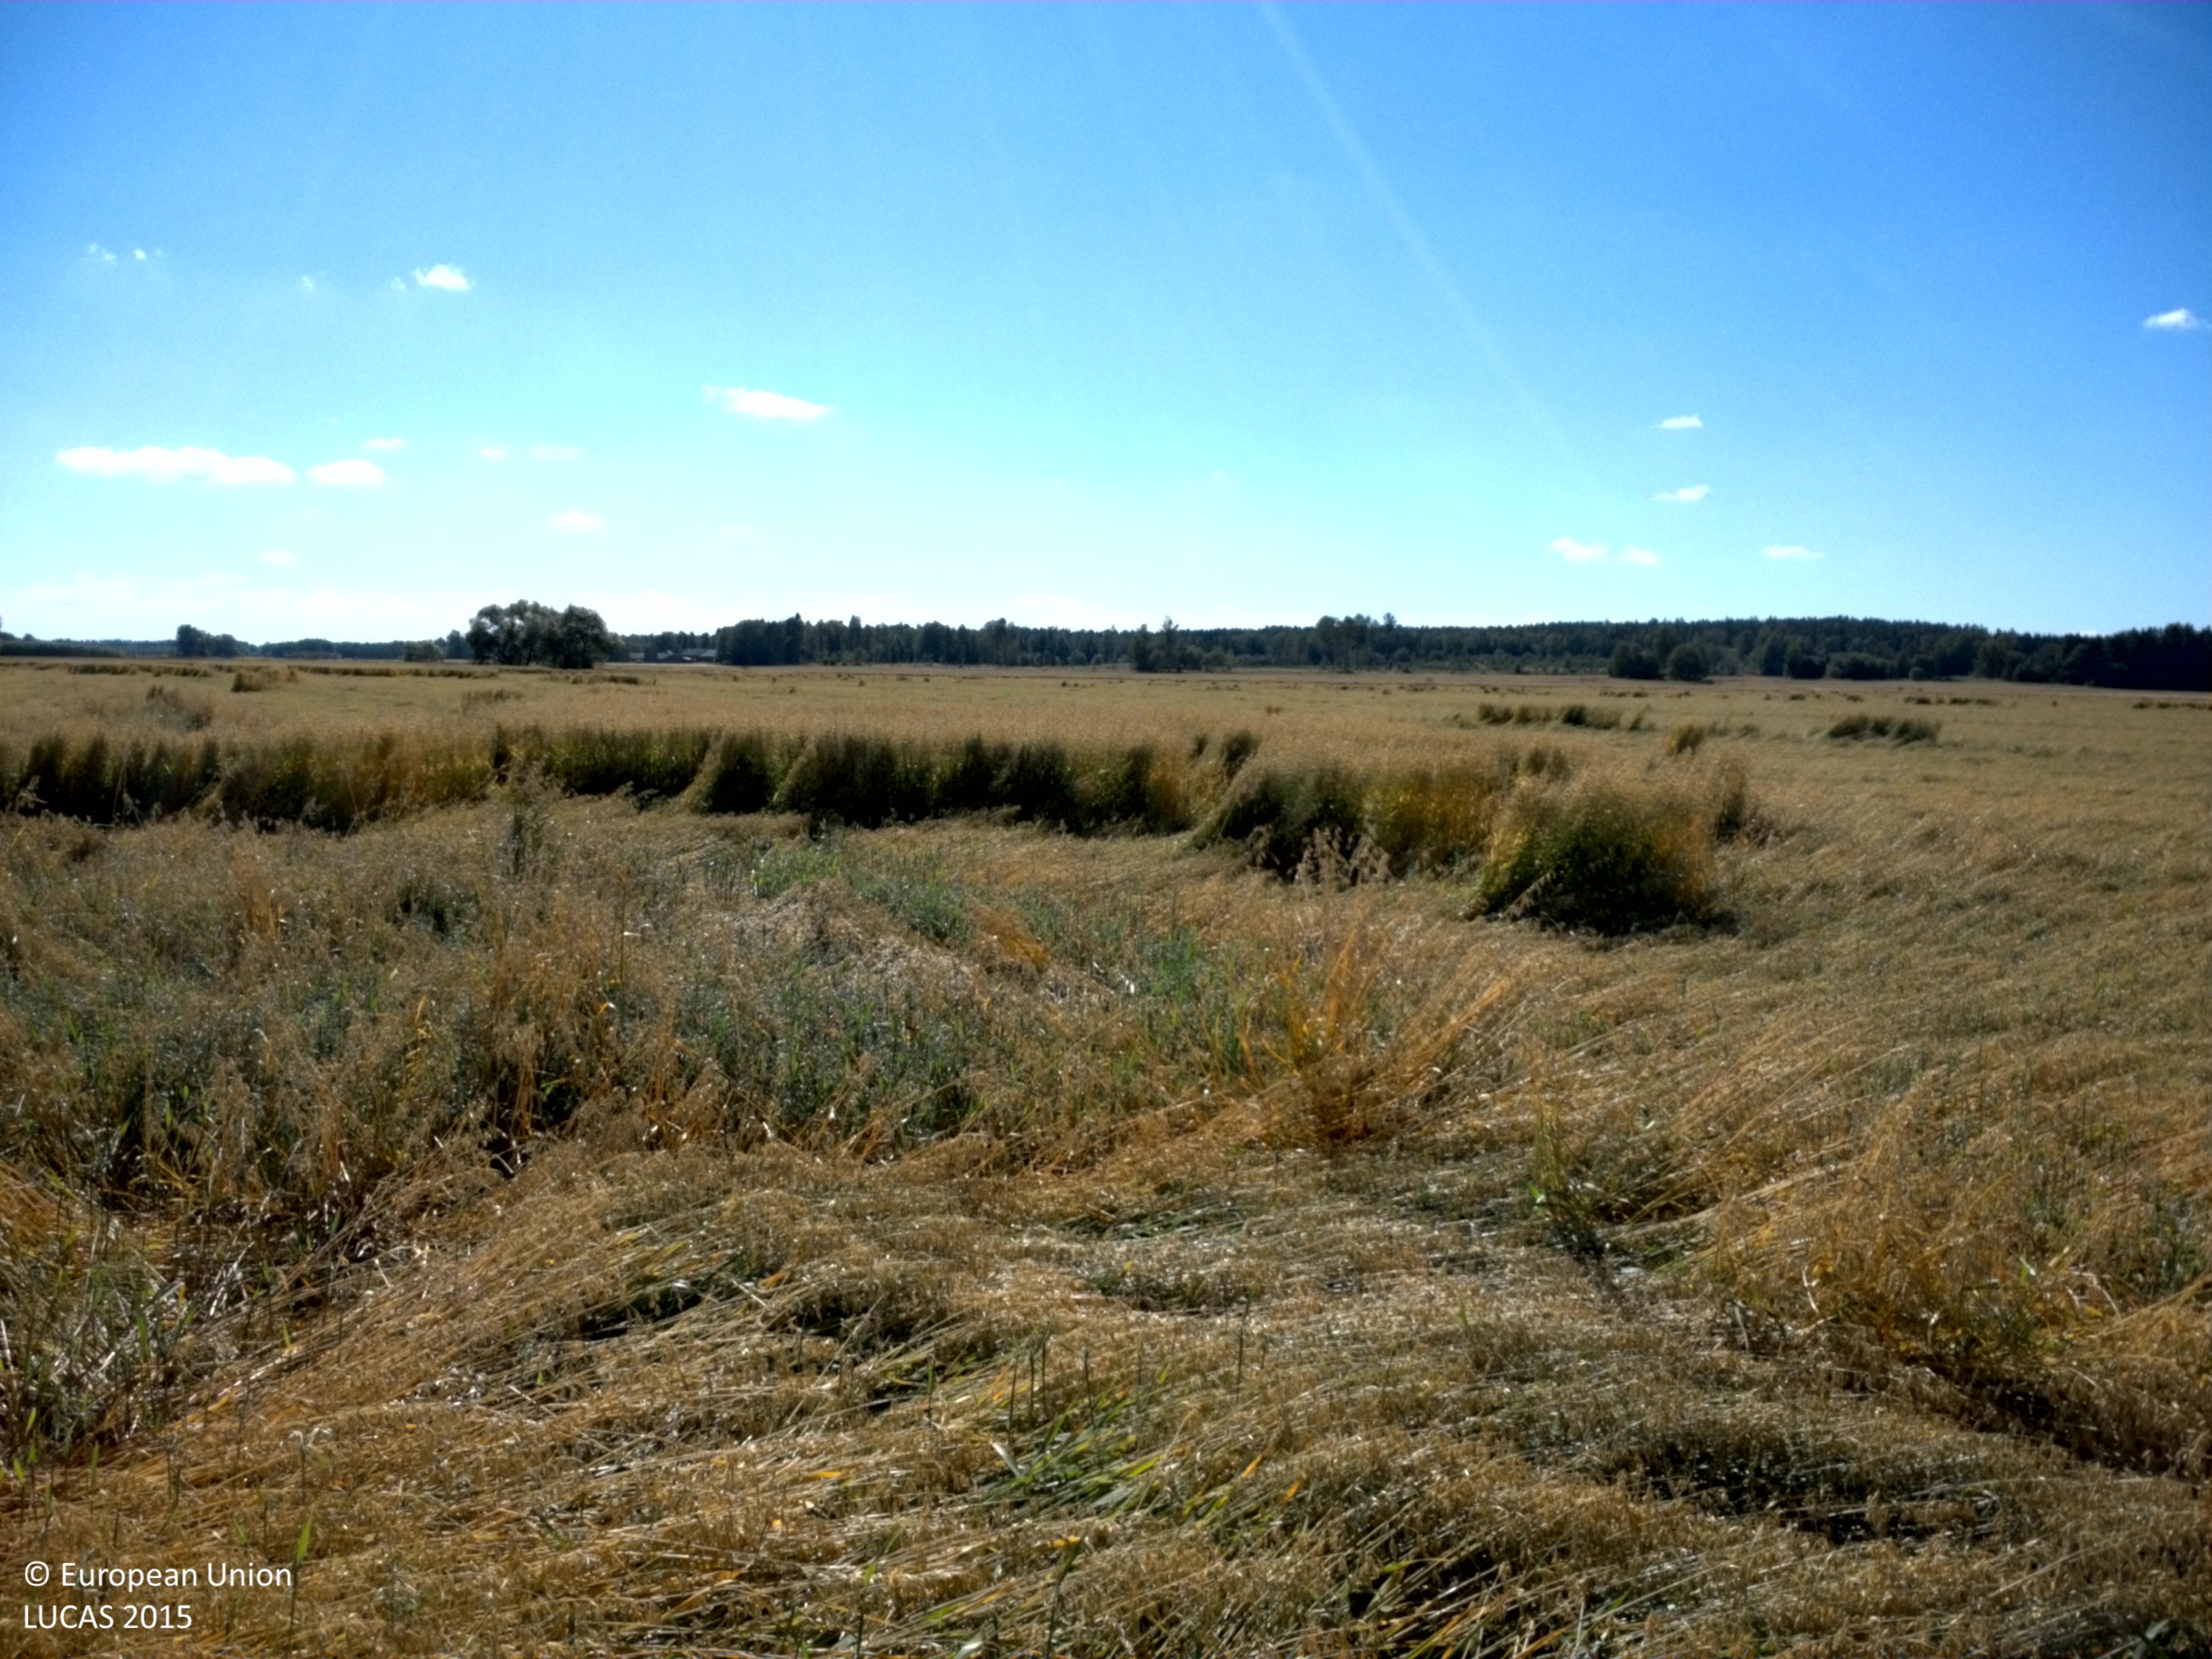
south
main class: Cropland
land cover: Oats
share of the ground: > 75 %
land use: Agriculture (excluding fallow land and kitchen gardens)
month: August
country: SE
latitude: 59.7716
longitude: 16.6340
